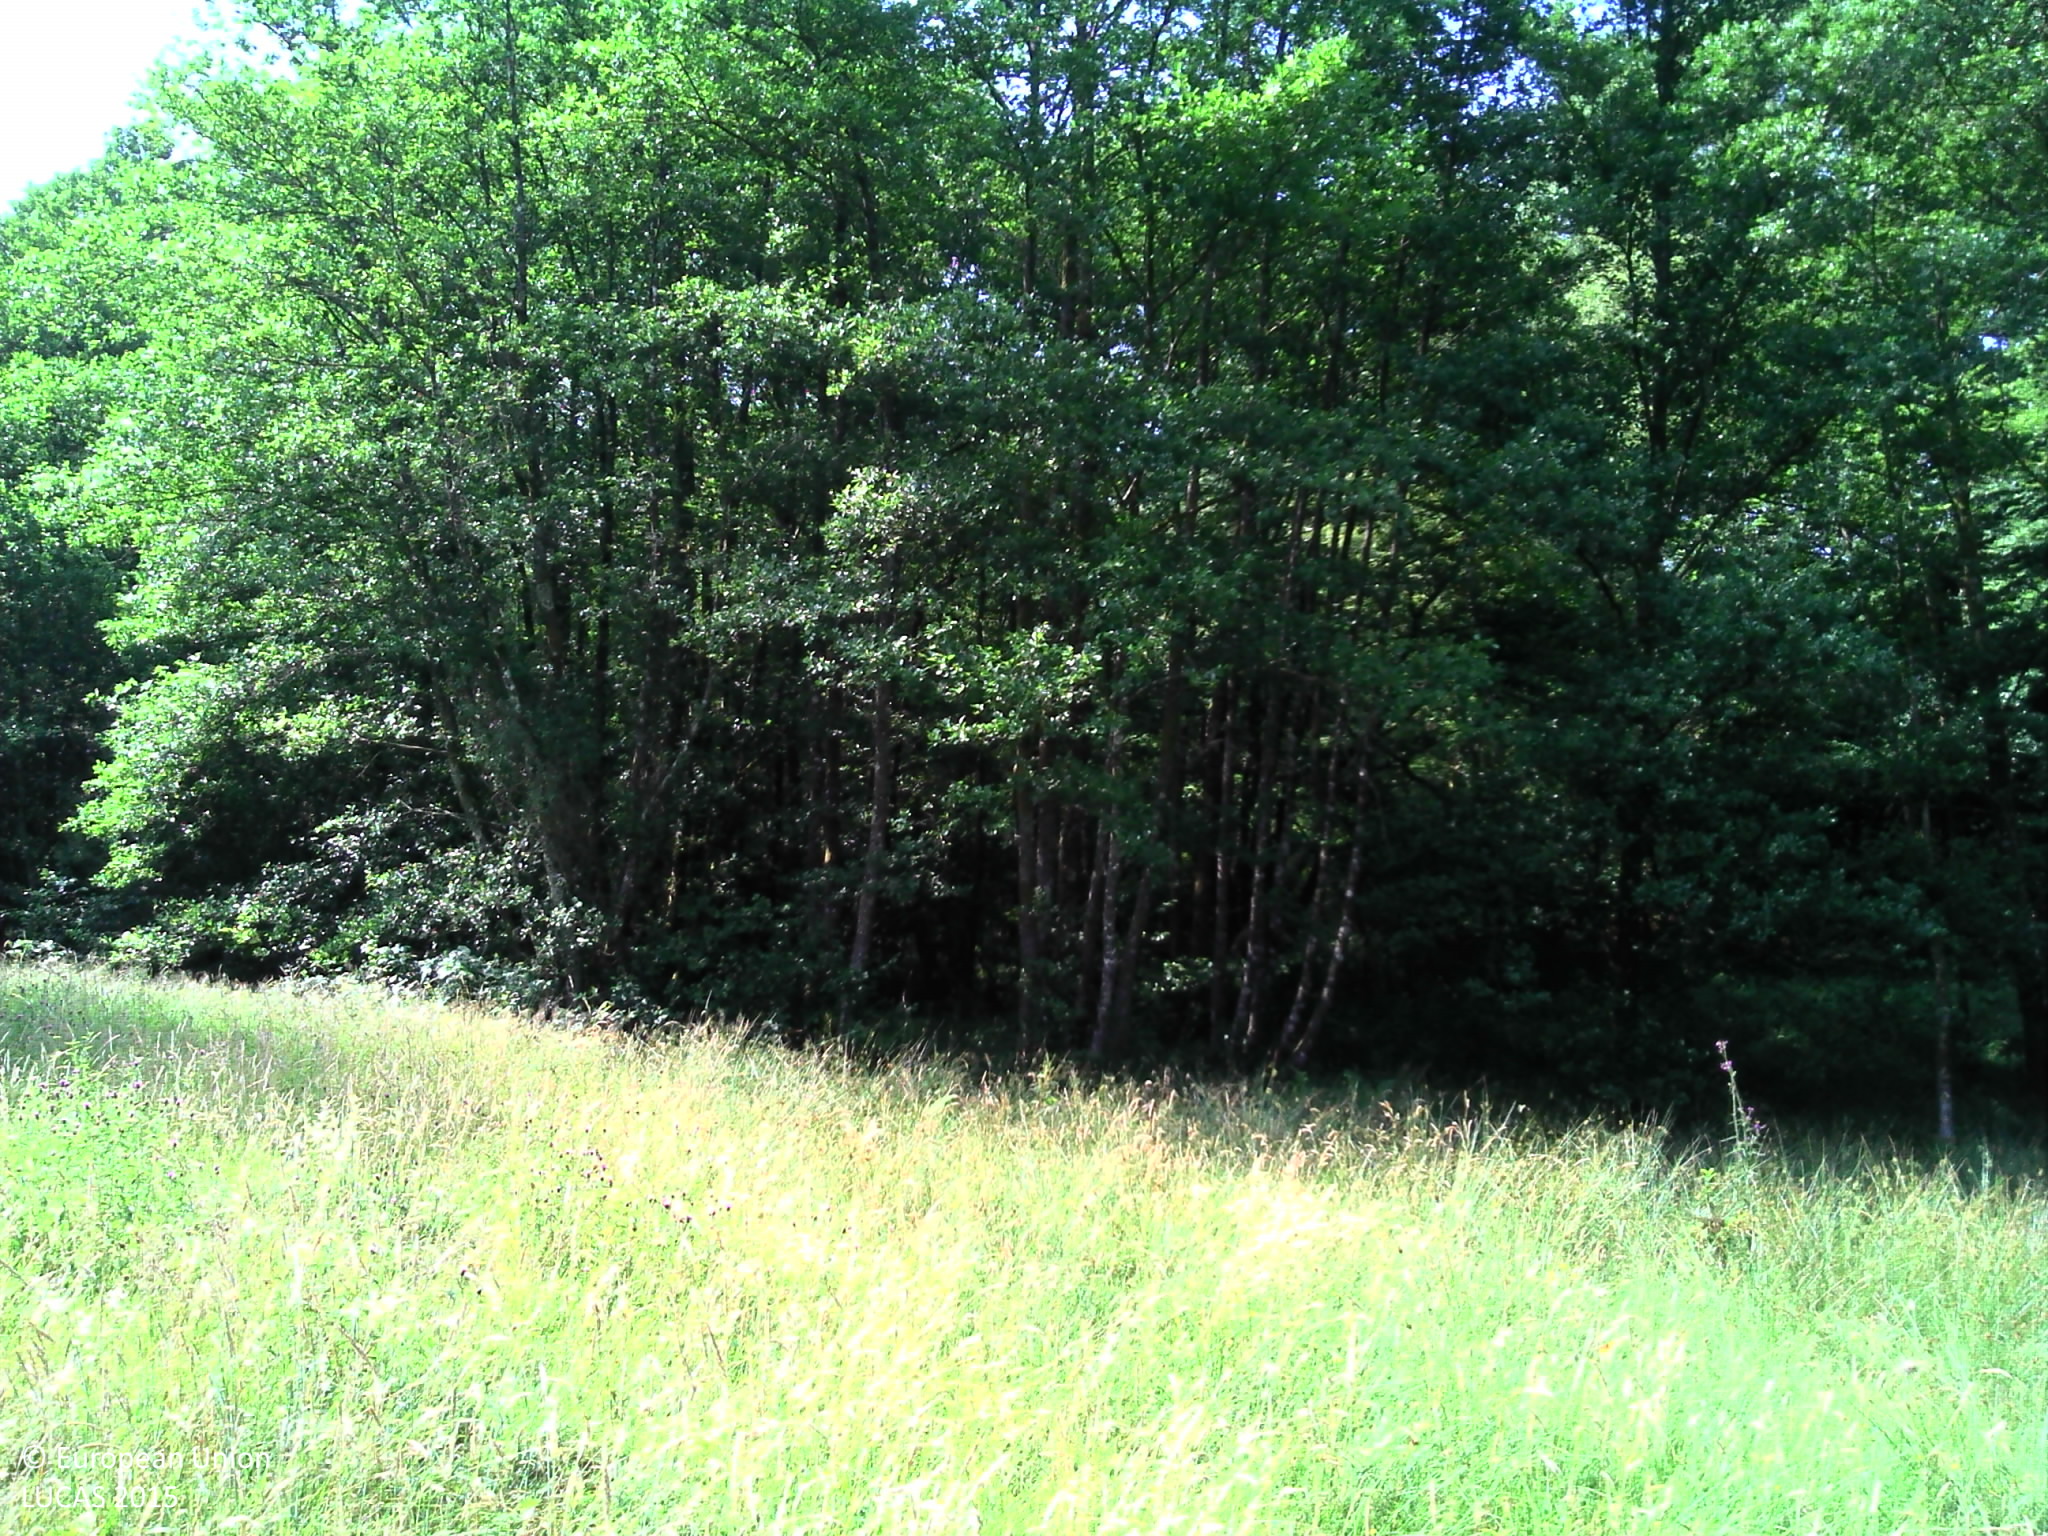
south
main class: Grassland
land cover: Grassland without tree/shrub cover
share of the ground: > 75 %
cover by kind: herbaceous plants 100 %
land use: Agriculture (excluding fallow land and kitchen gardens)
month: July
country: FR
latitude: 45.8005
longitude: 1.7982
